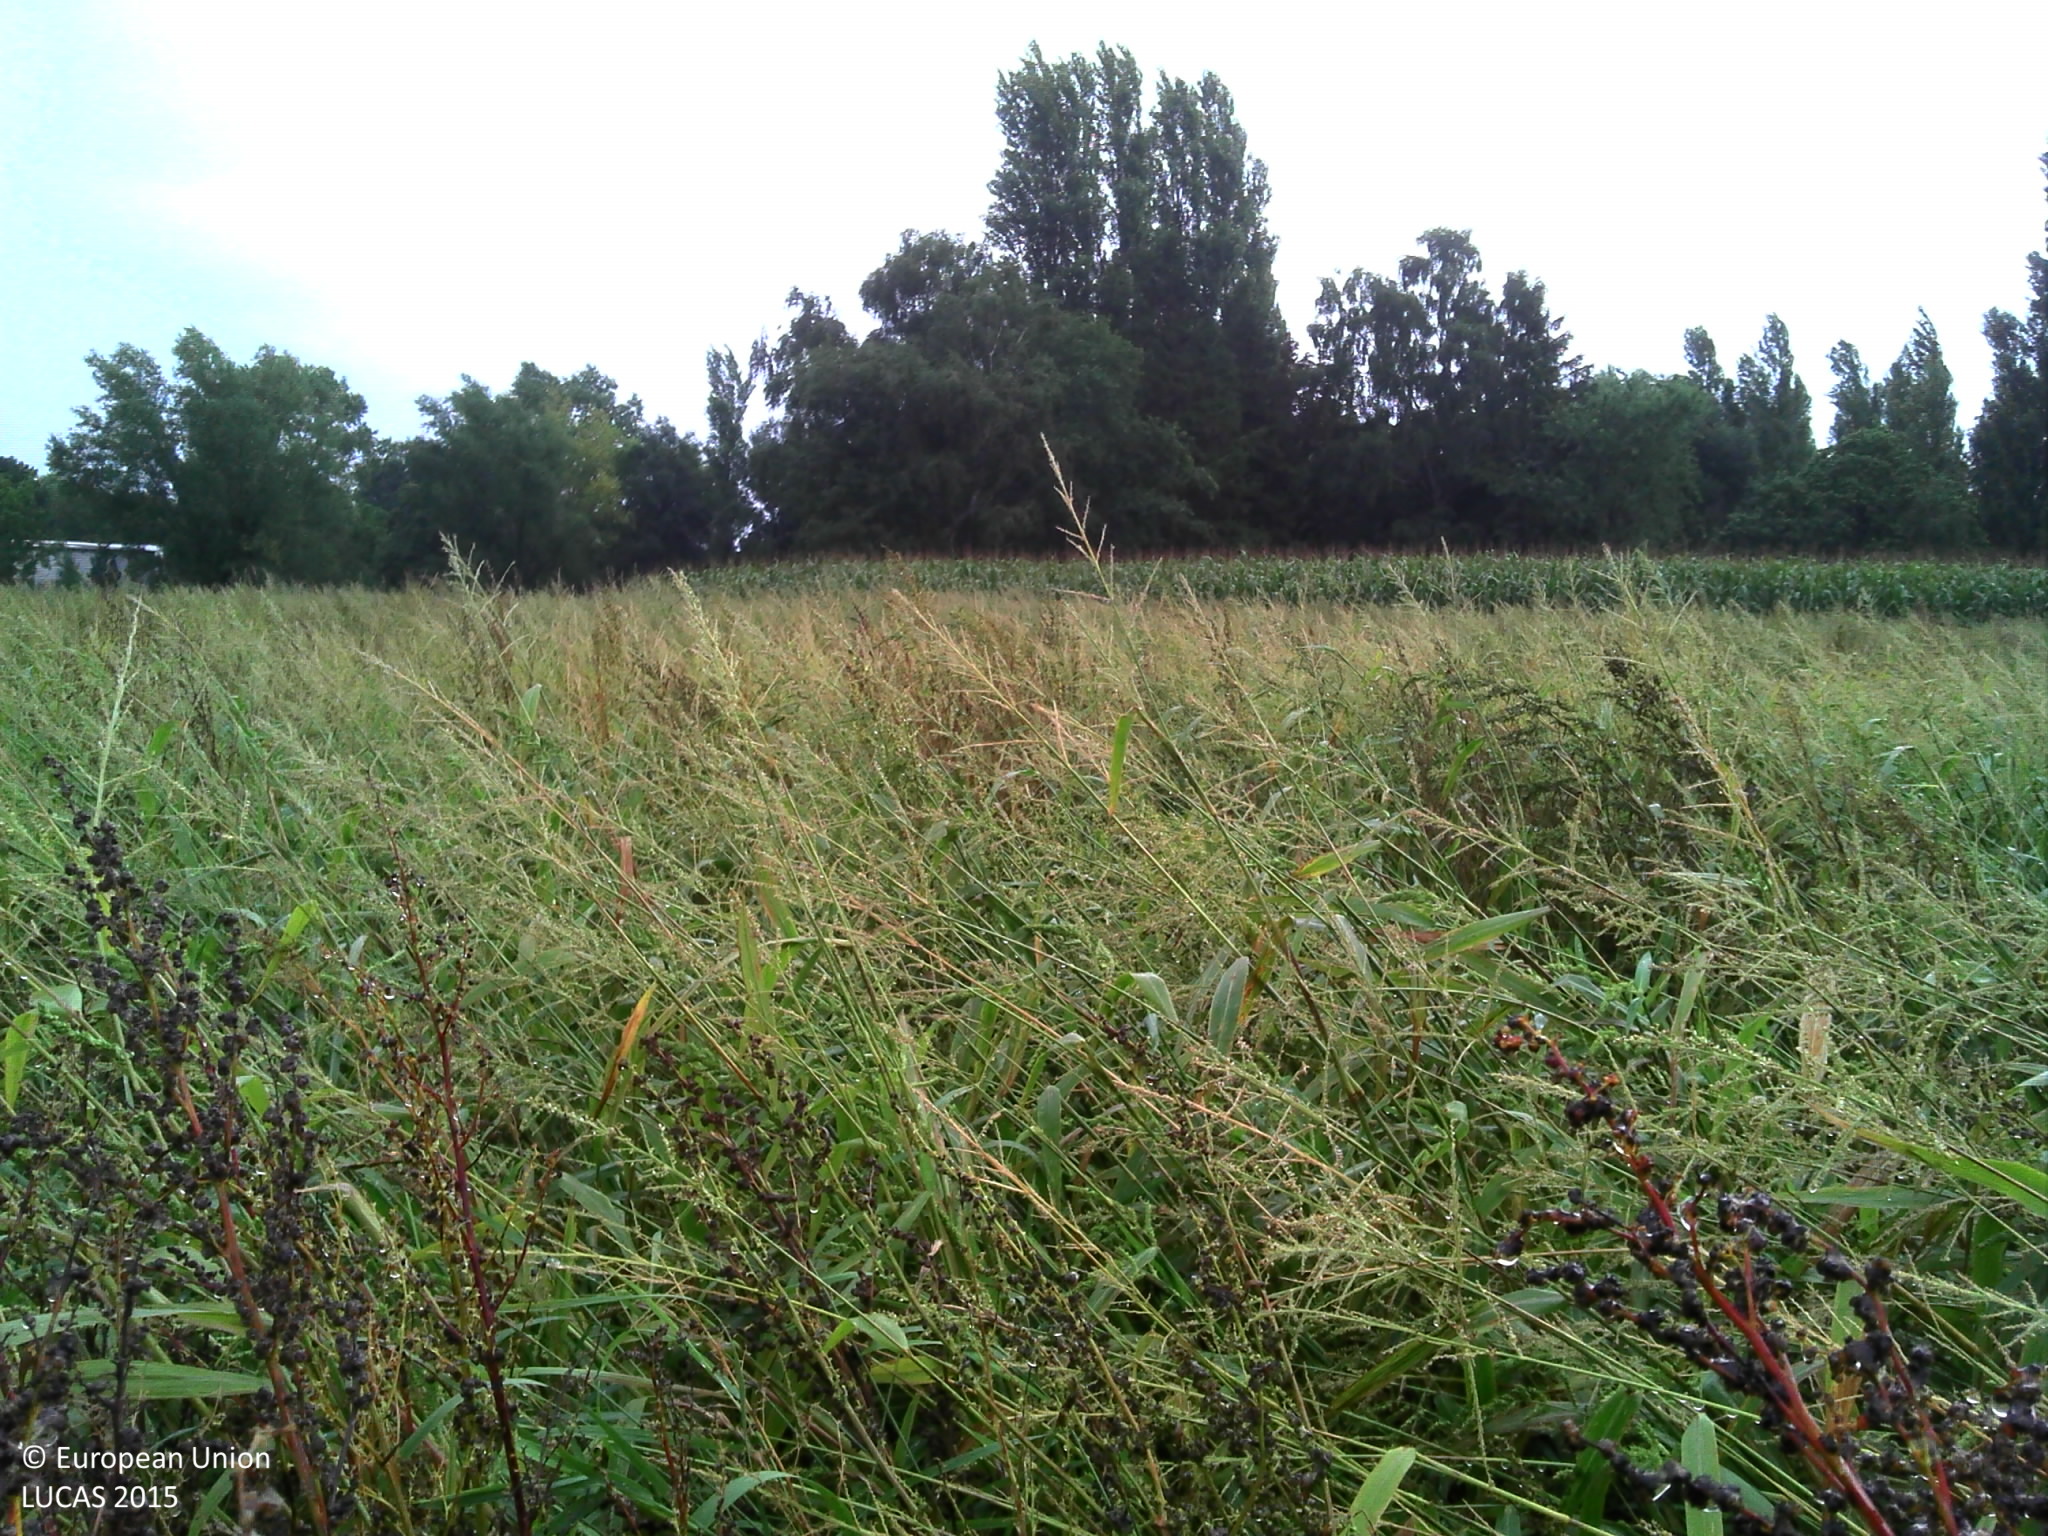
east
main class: Grassland
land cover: Spontaneously vegetated surfaces
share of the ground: > 75 %
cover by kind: herbaceous plants 100 %
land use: Fallow land
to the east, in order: Spontaneously vegetated surfaces; Maize; Lines of trees; Tracks; Lines of trees; Ditches and canals; Fences; Grassland without tree/shrub cover; Fences; Grassland without tree/shrub cover; Fences; Grassland without tree/shrub cover; Fences; Broadleaved woodland; Artificial constructions in urban areas
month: September
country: BE
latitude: 51.1797
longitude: 3.0234
